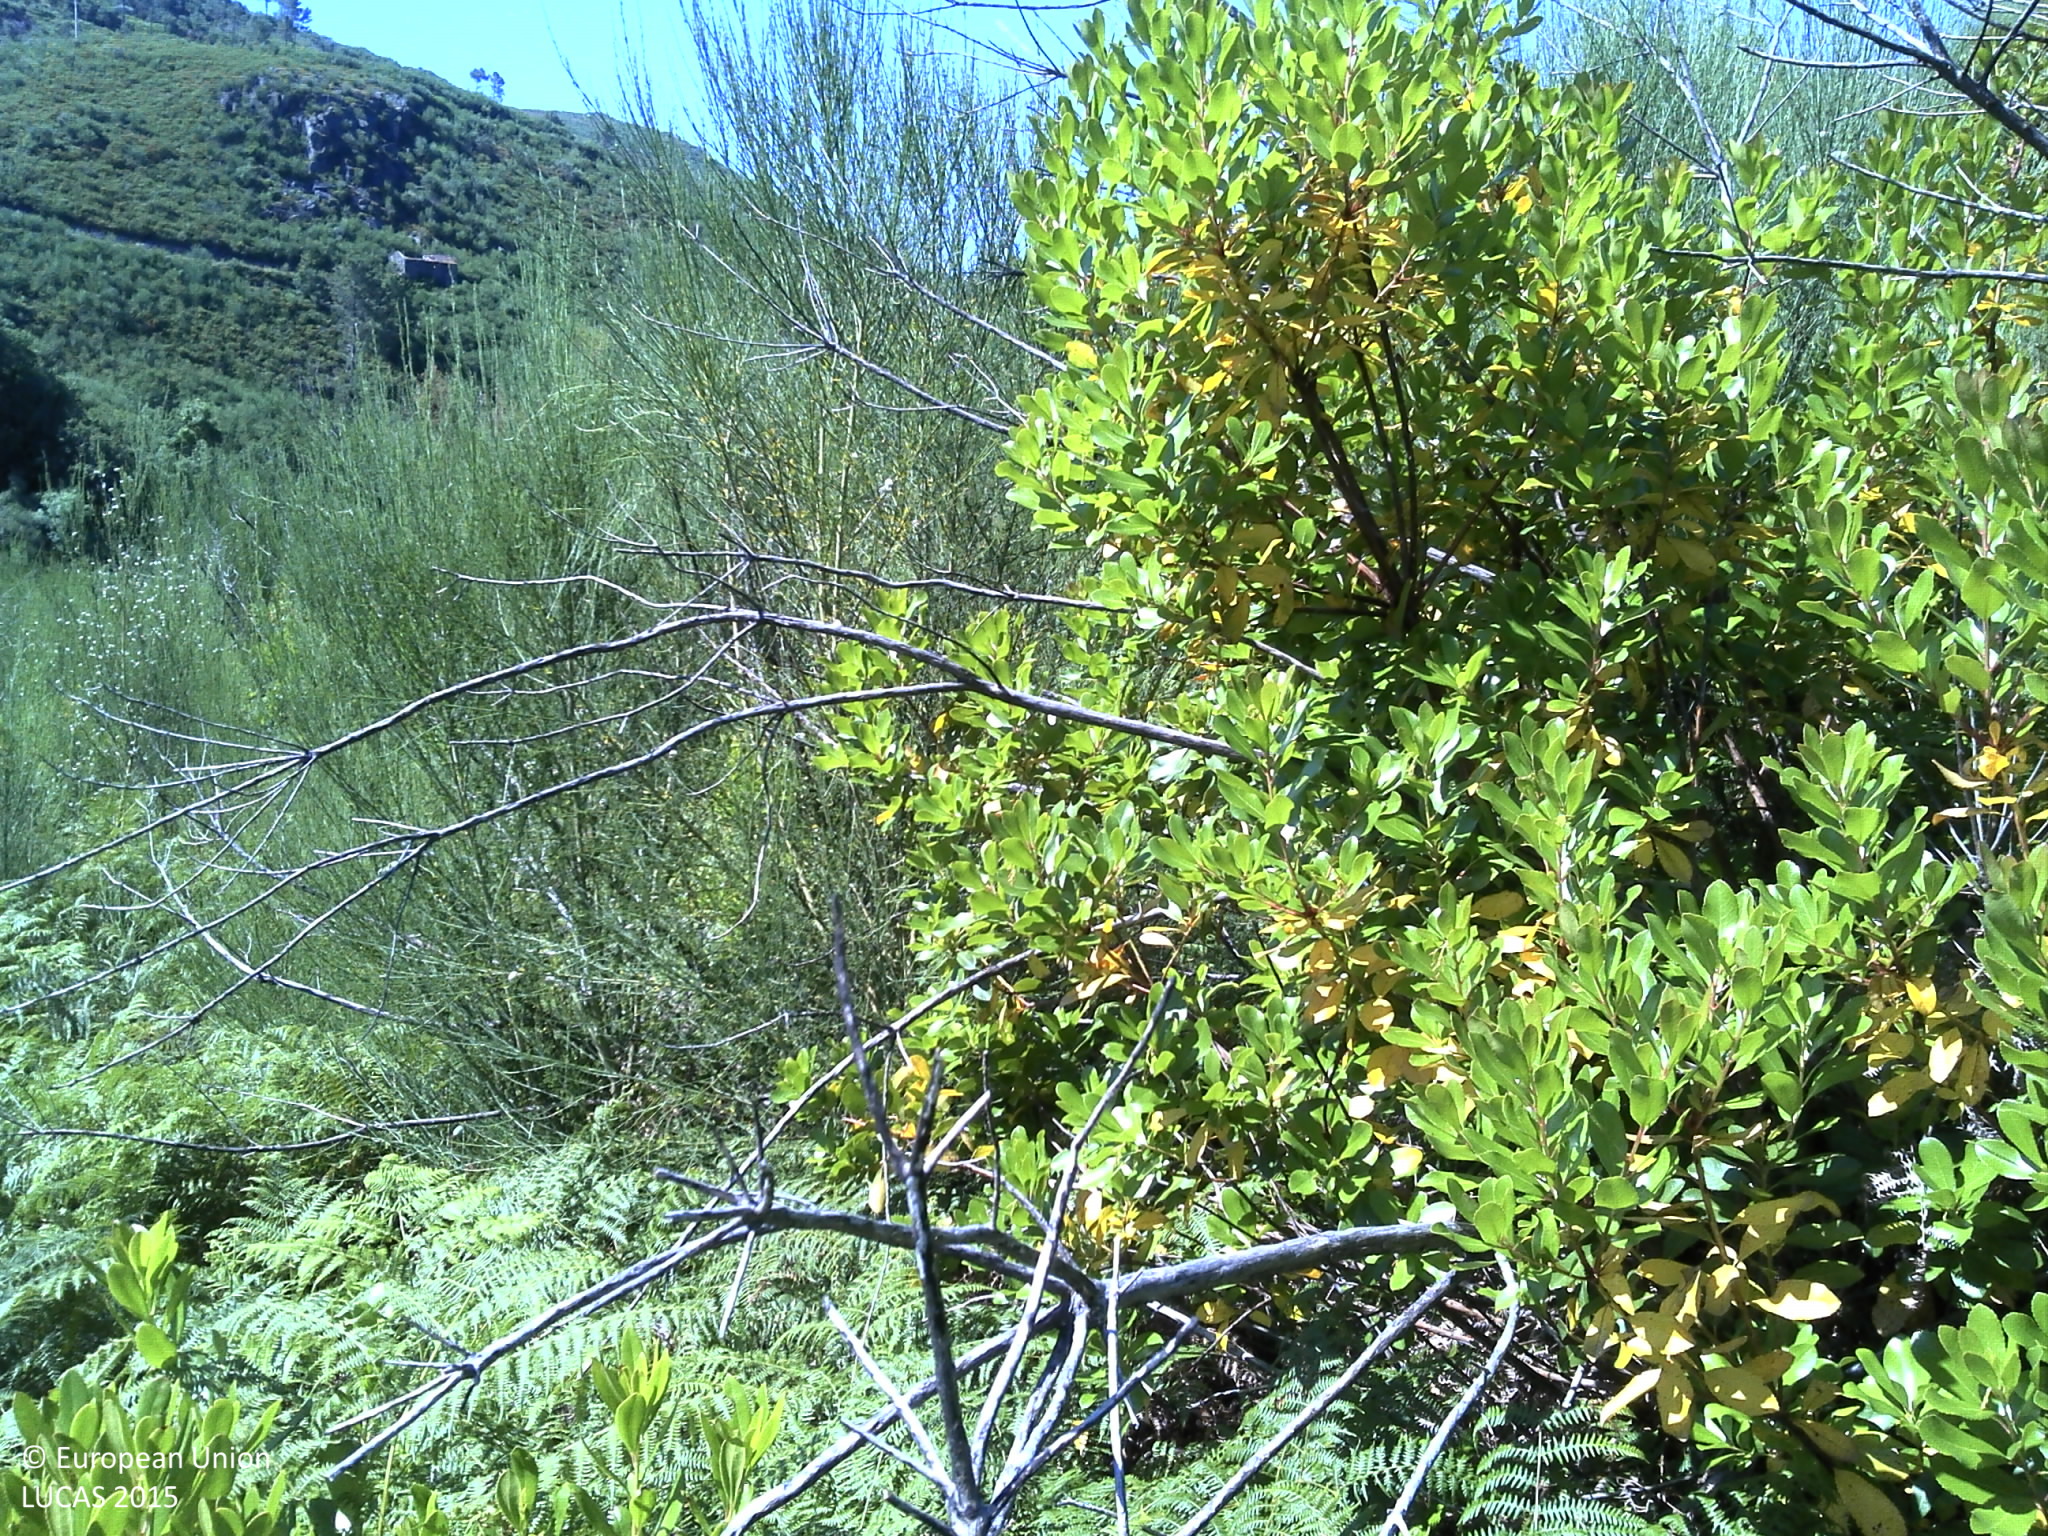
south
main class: Shrubland
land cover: Shrubland without tree cover
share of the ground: > 75 %
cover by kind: shrubs 75 %, herbaceous plants 10 %, consolidated bare surface 10 %, unconsolidated bare surface 5 %
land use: Semi-natural and natural areas not in use
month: June
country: PT
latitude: 41.8419
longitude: -8.2790
